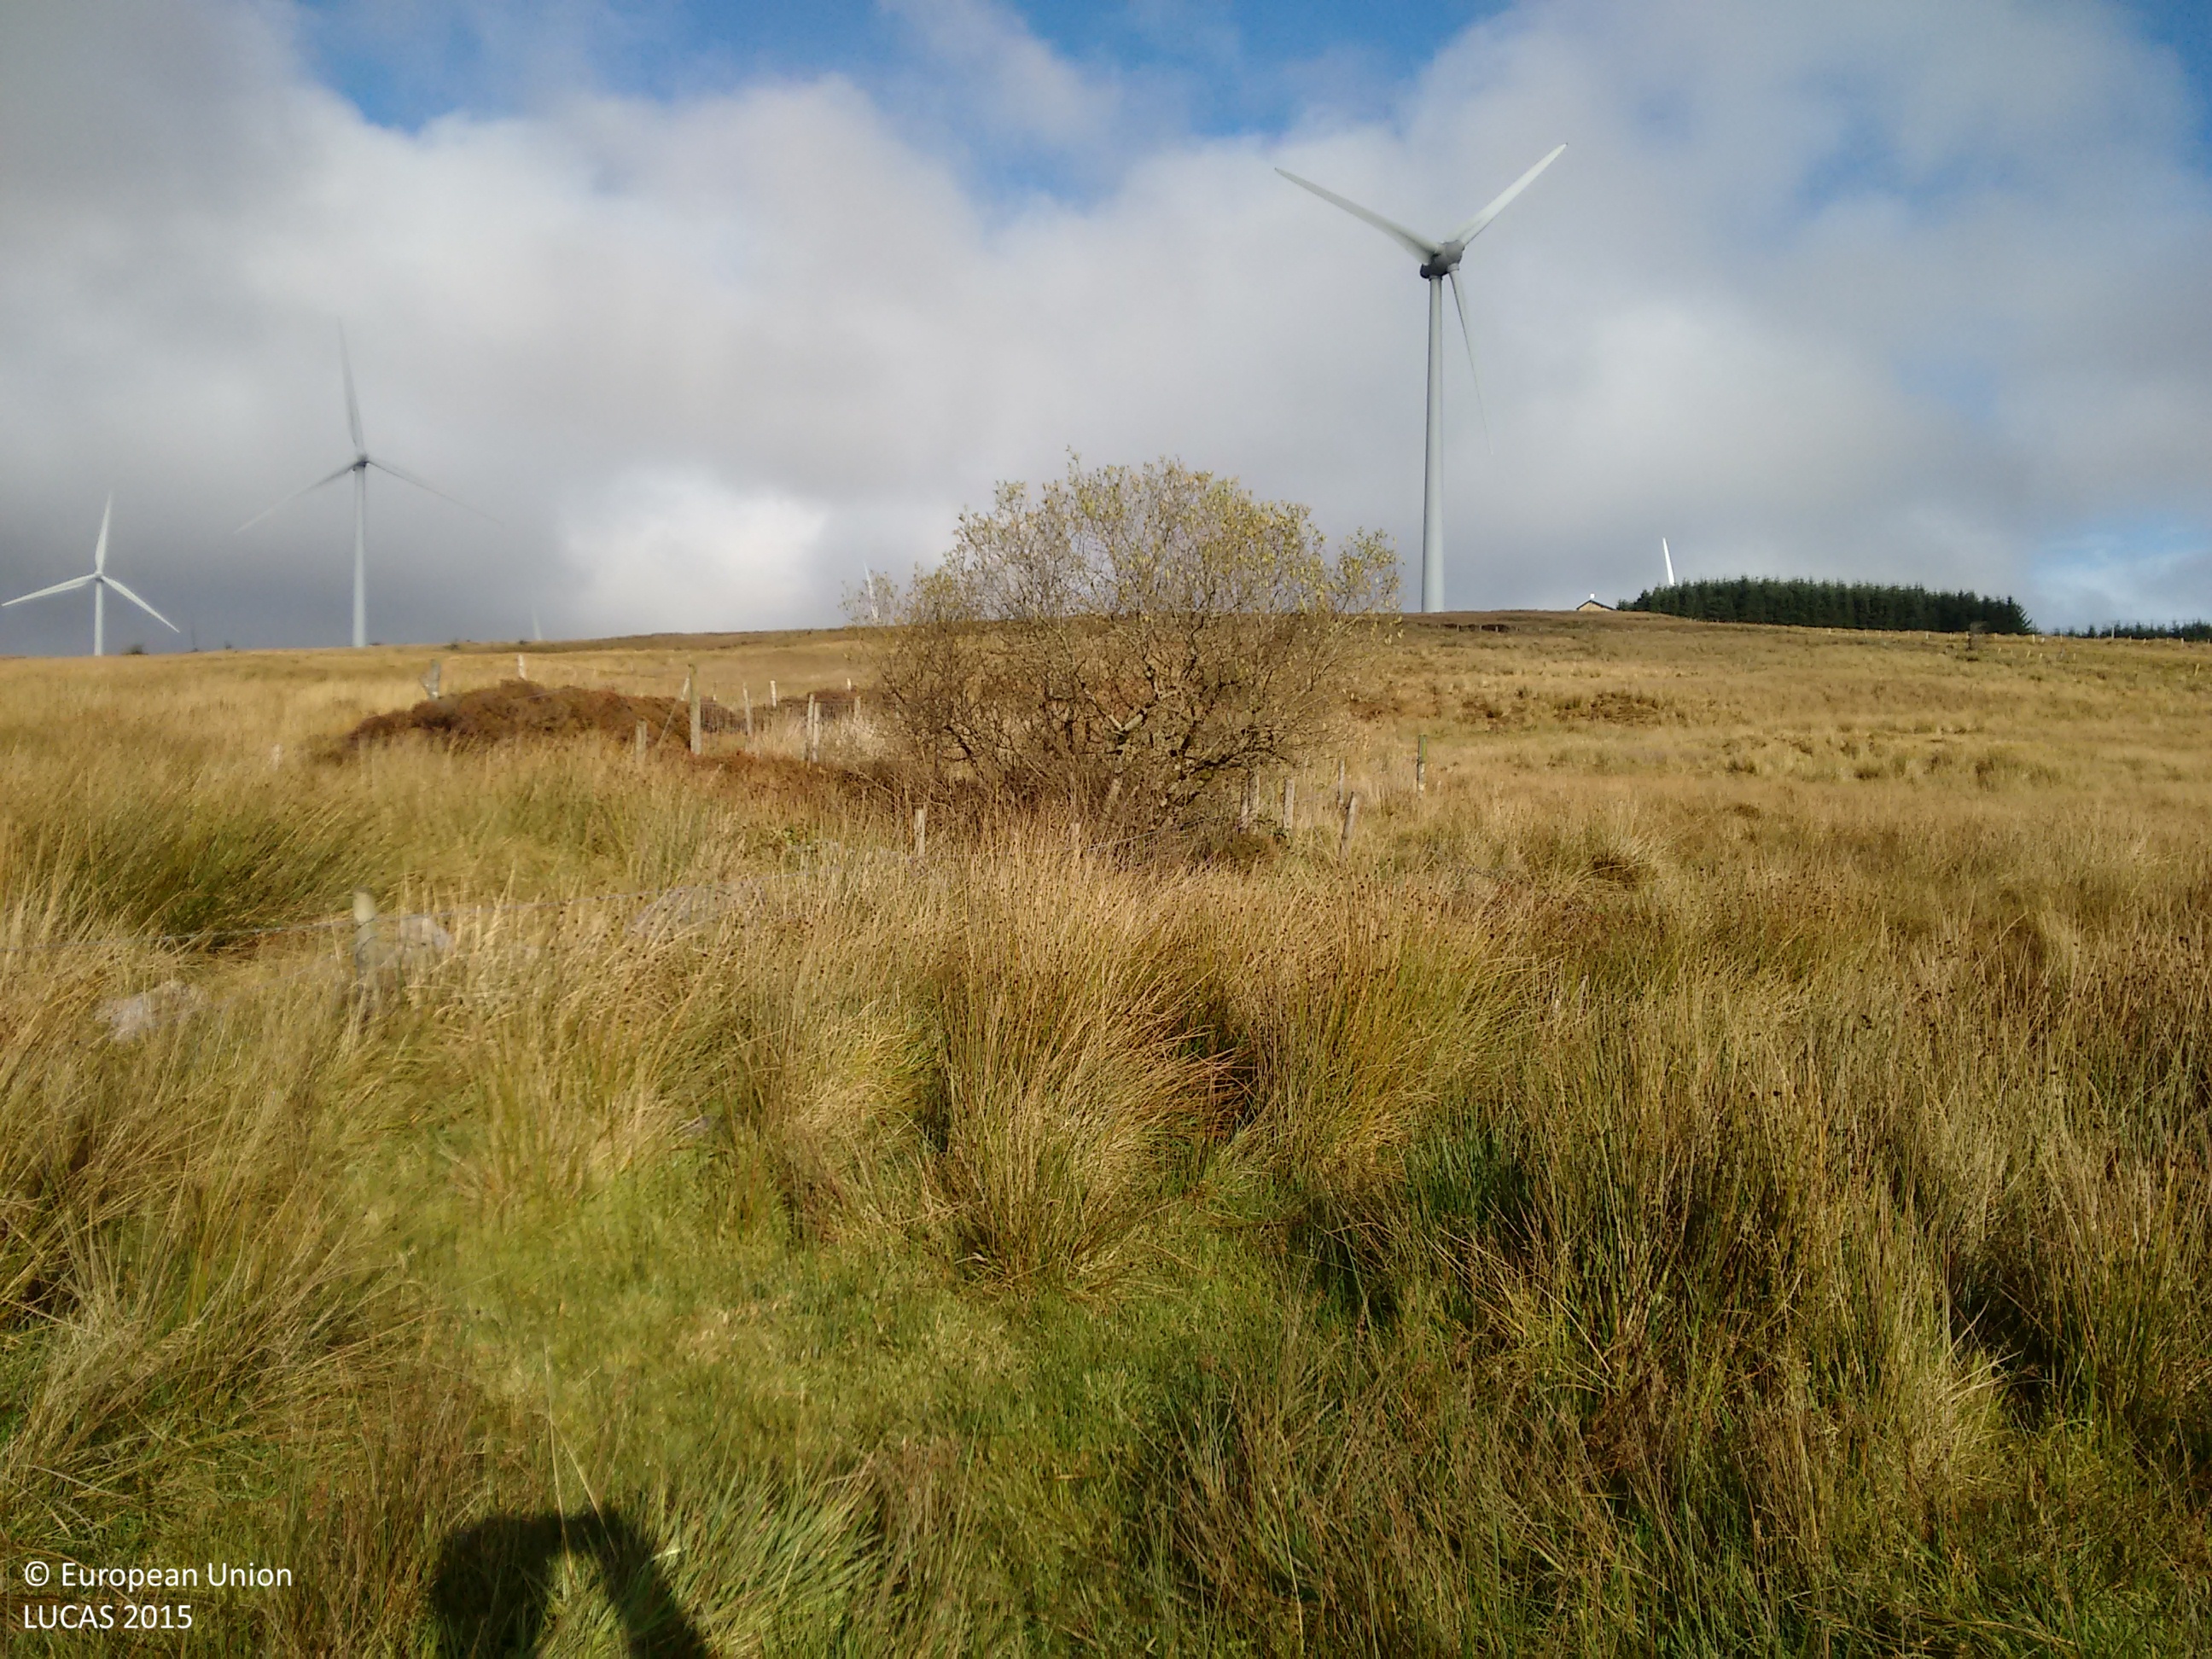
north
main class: Grassland
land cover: Grassland without tree/shrub cover
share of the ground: > 75 %
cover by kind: herbaceous plants 100 %
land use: Agriculture (excluding fallow land and kitchen gardens)
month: October
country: IE
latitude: 54.1045
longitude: -8.1180
